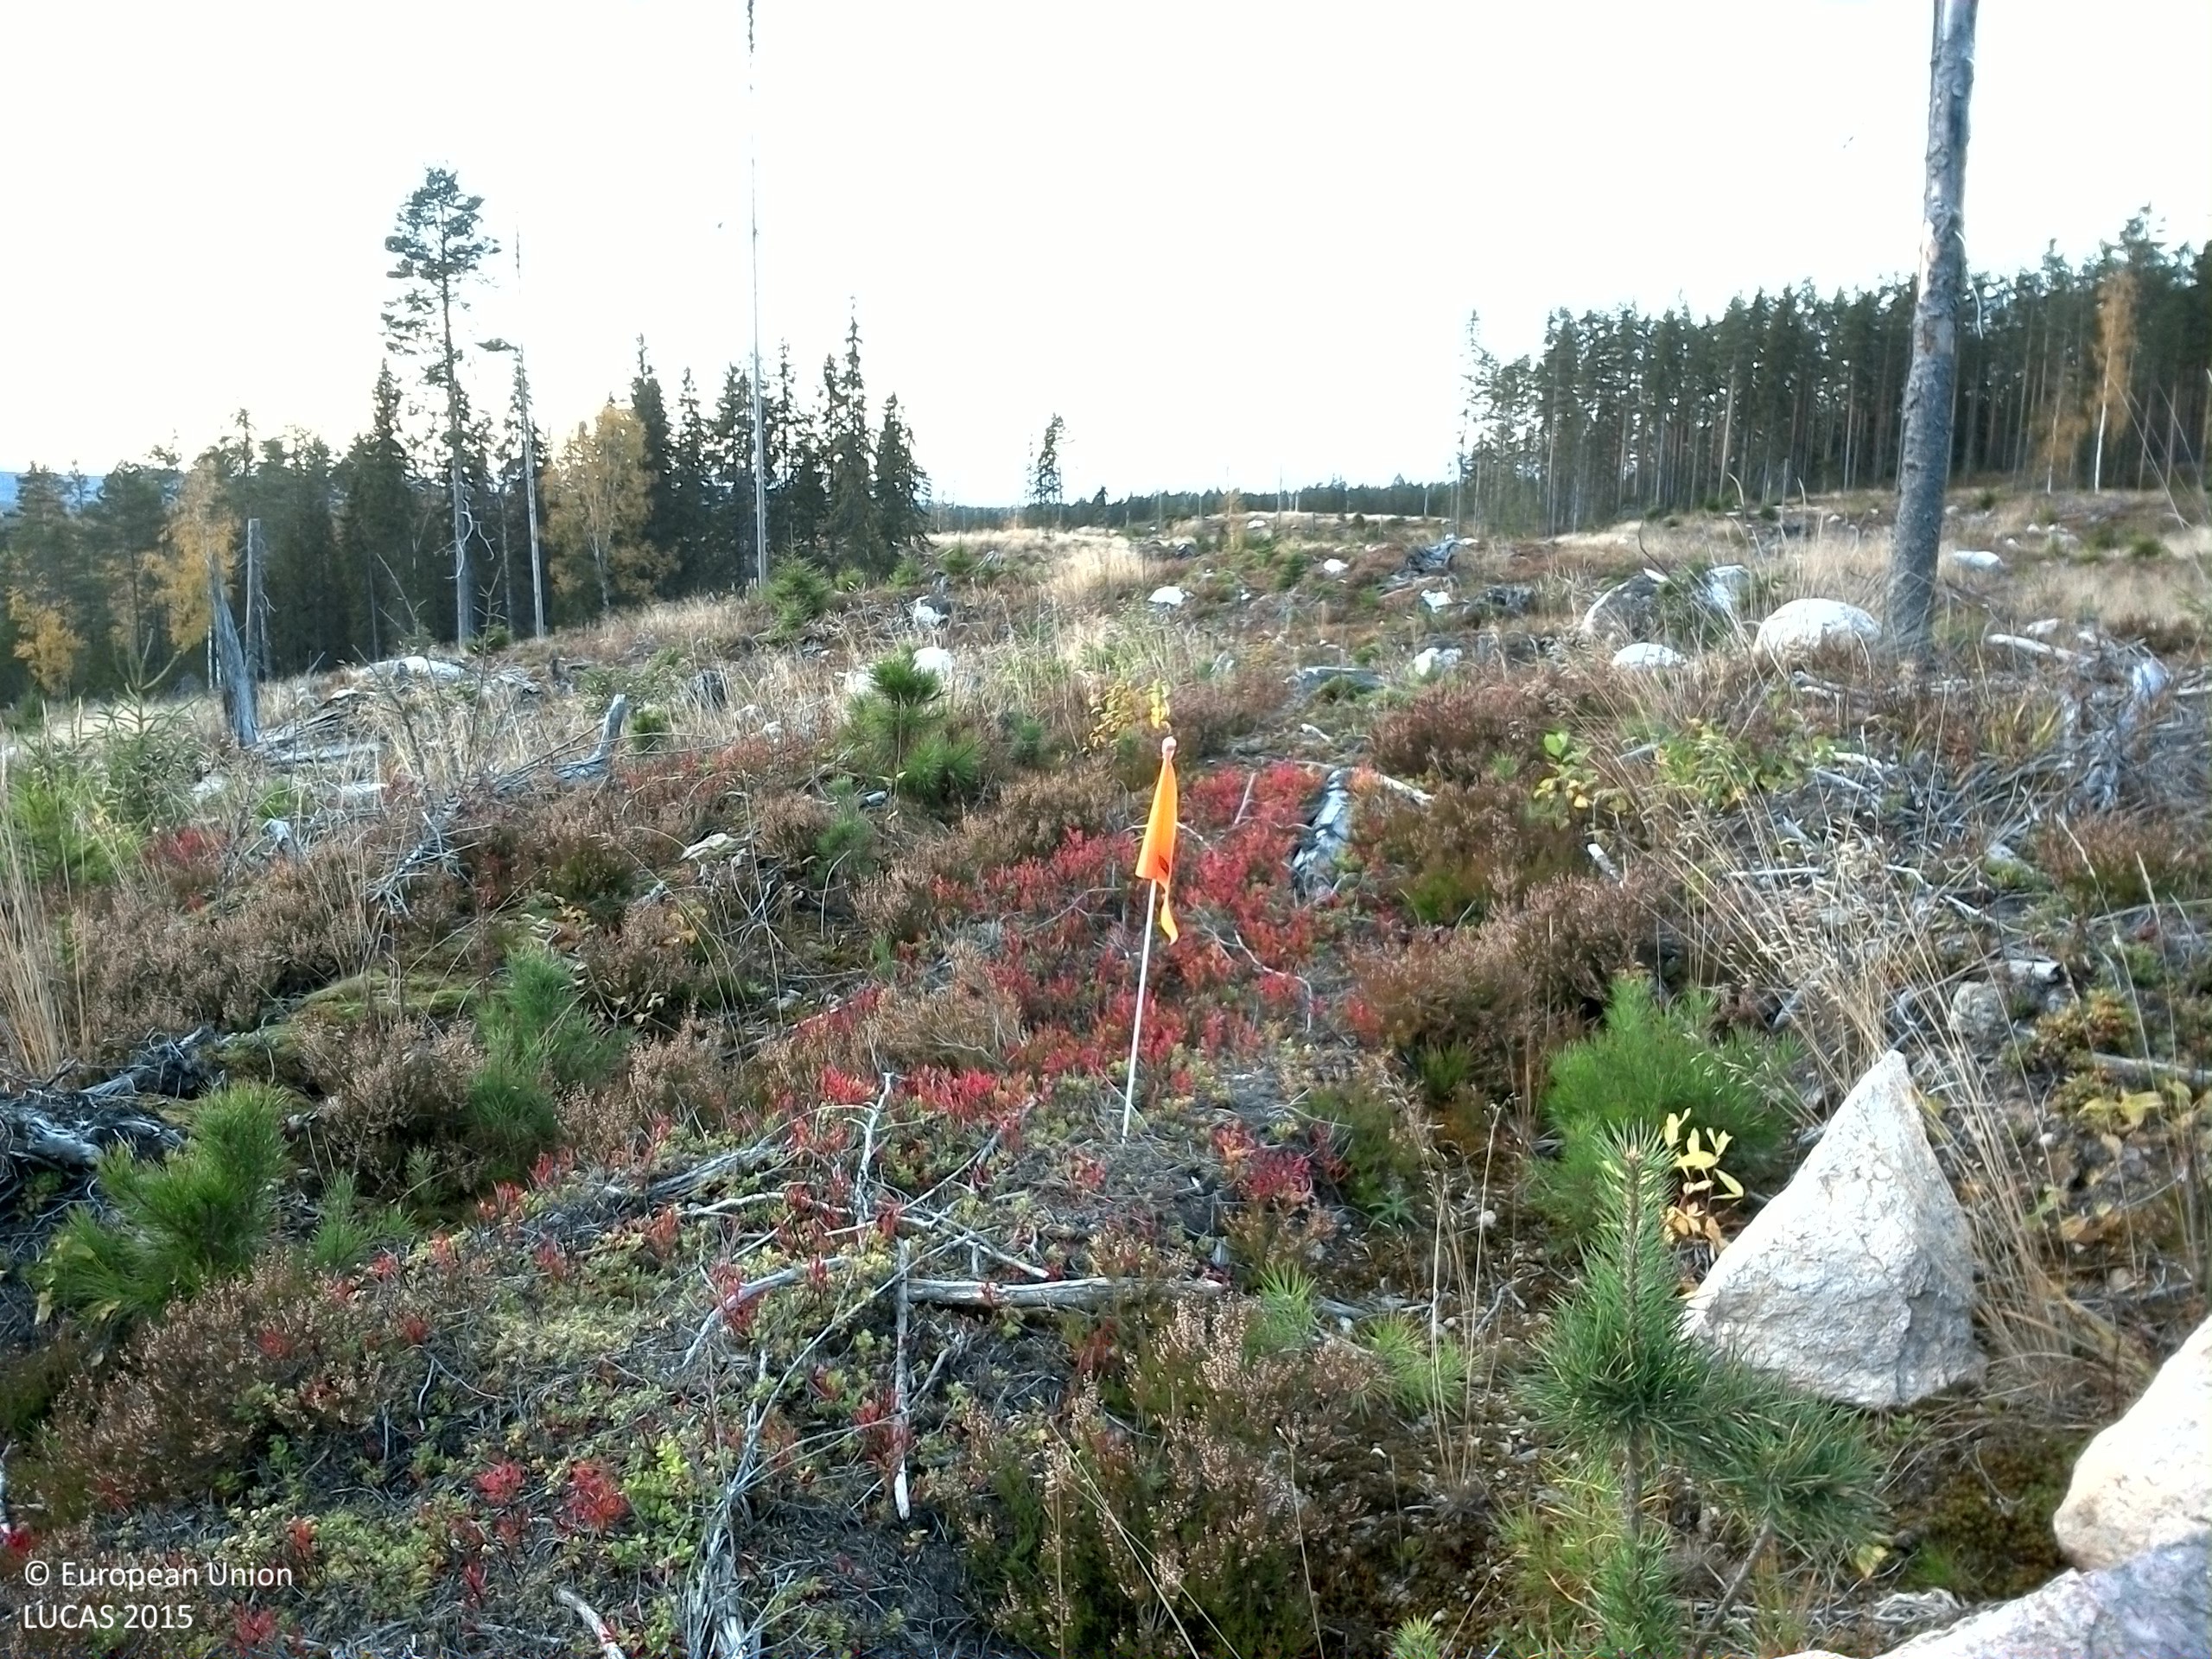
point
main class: Shrubland
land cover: Shrubland with sparse tree cover
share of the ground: > 75 %
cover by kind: shrubs 50 %, herbaceous plants 15 %, lichens and mosses 15 %, consolidated bare surface 15 %, coniferous forest trees 5 %
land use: Forestry
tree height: < 5 m
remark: Clear cut
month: October
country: SE
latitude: 61.4074
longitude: 15.0608
